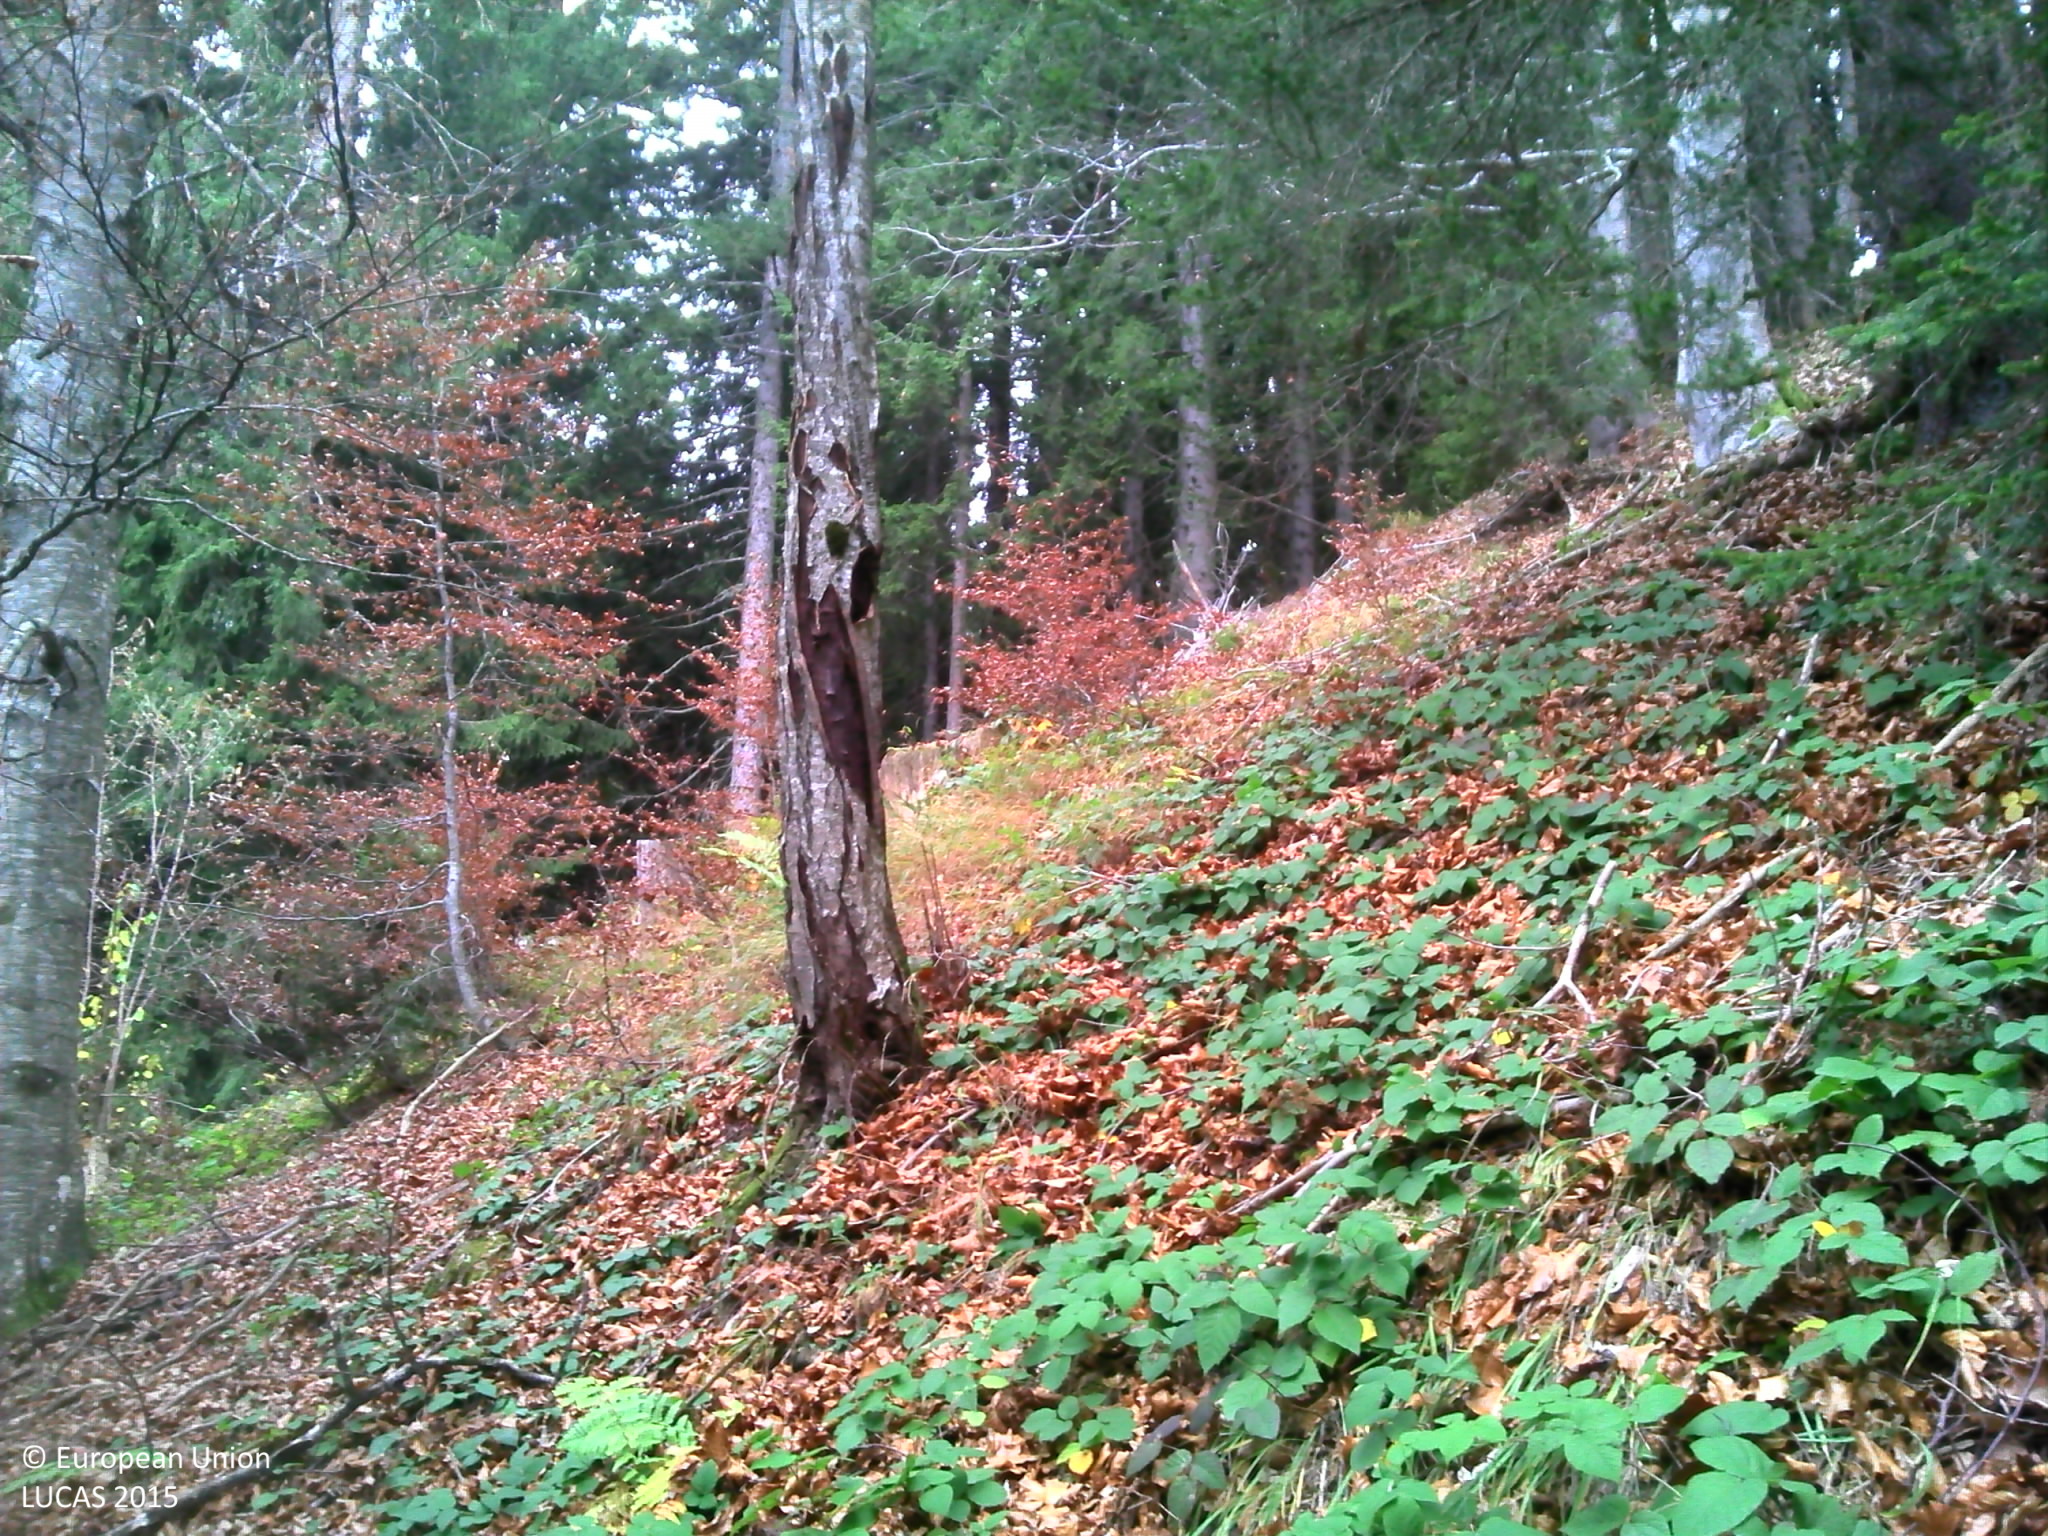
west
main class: Woodland
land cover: Spruce dominated mixed woodland
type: mountainous beech forest
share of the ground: > 75 %
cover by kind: coniferous forest trees 60 %, broadleaved forest trees 30 %, herbaceous plants 10 %
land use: Forestry
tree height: > 5 m
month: November
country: FR
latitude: 45.7880
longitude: 6.4667
